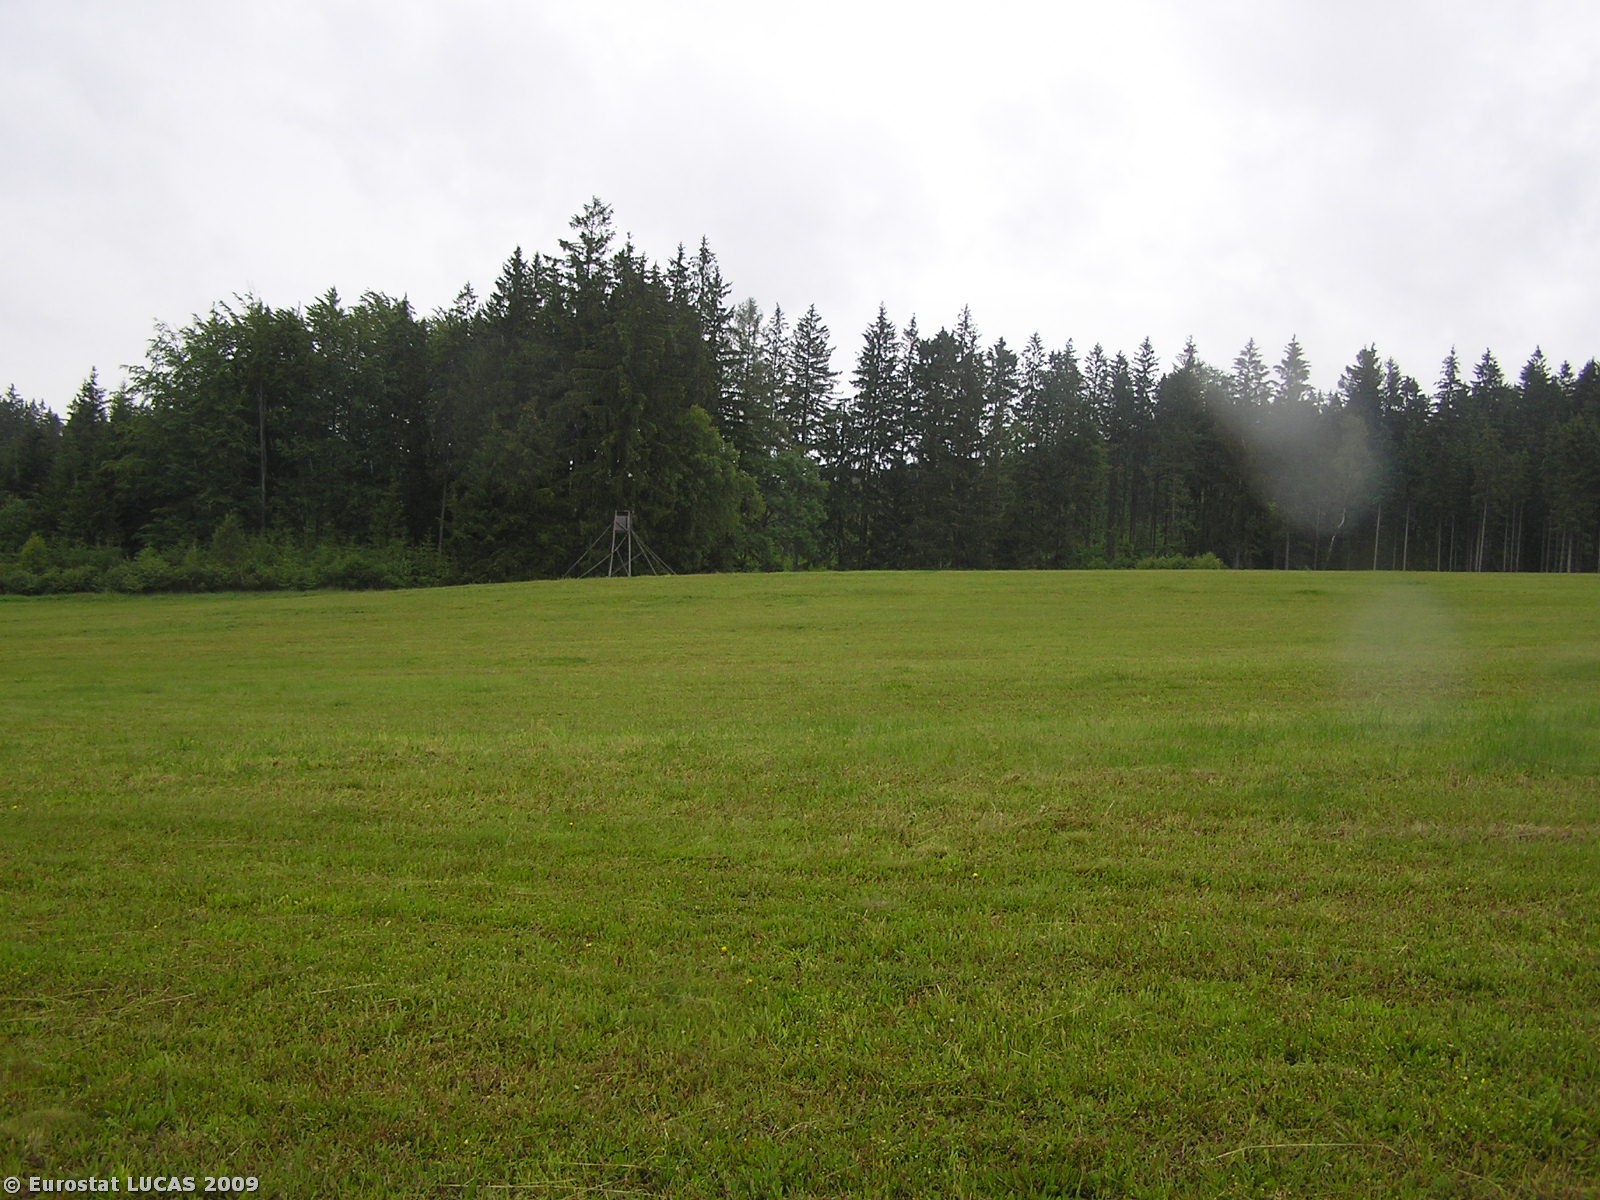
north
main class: Grassland
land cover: Grassland without tree/shrub cover
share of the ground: > 75 %
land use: Agriculture (excluding fallow land and kitchen gardens)
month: June
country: CZ
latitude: 49.2474
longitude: 14.9613
